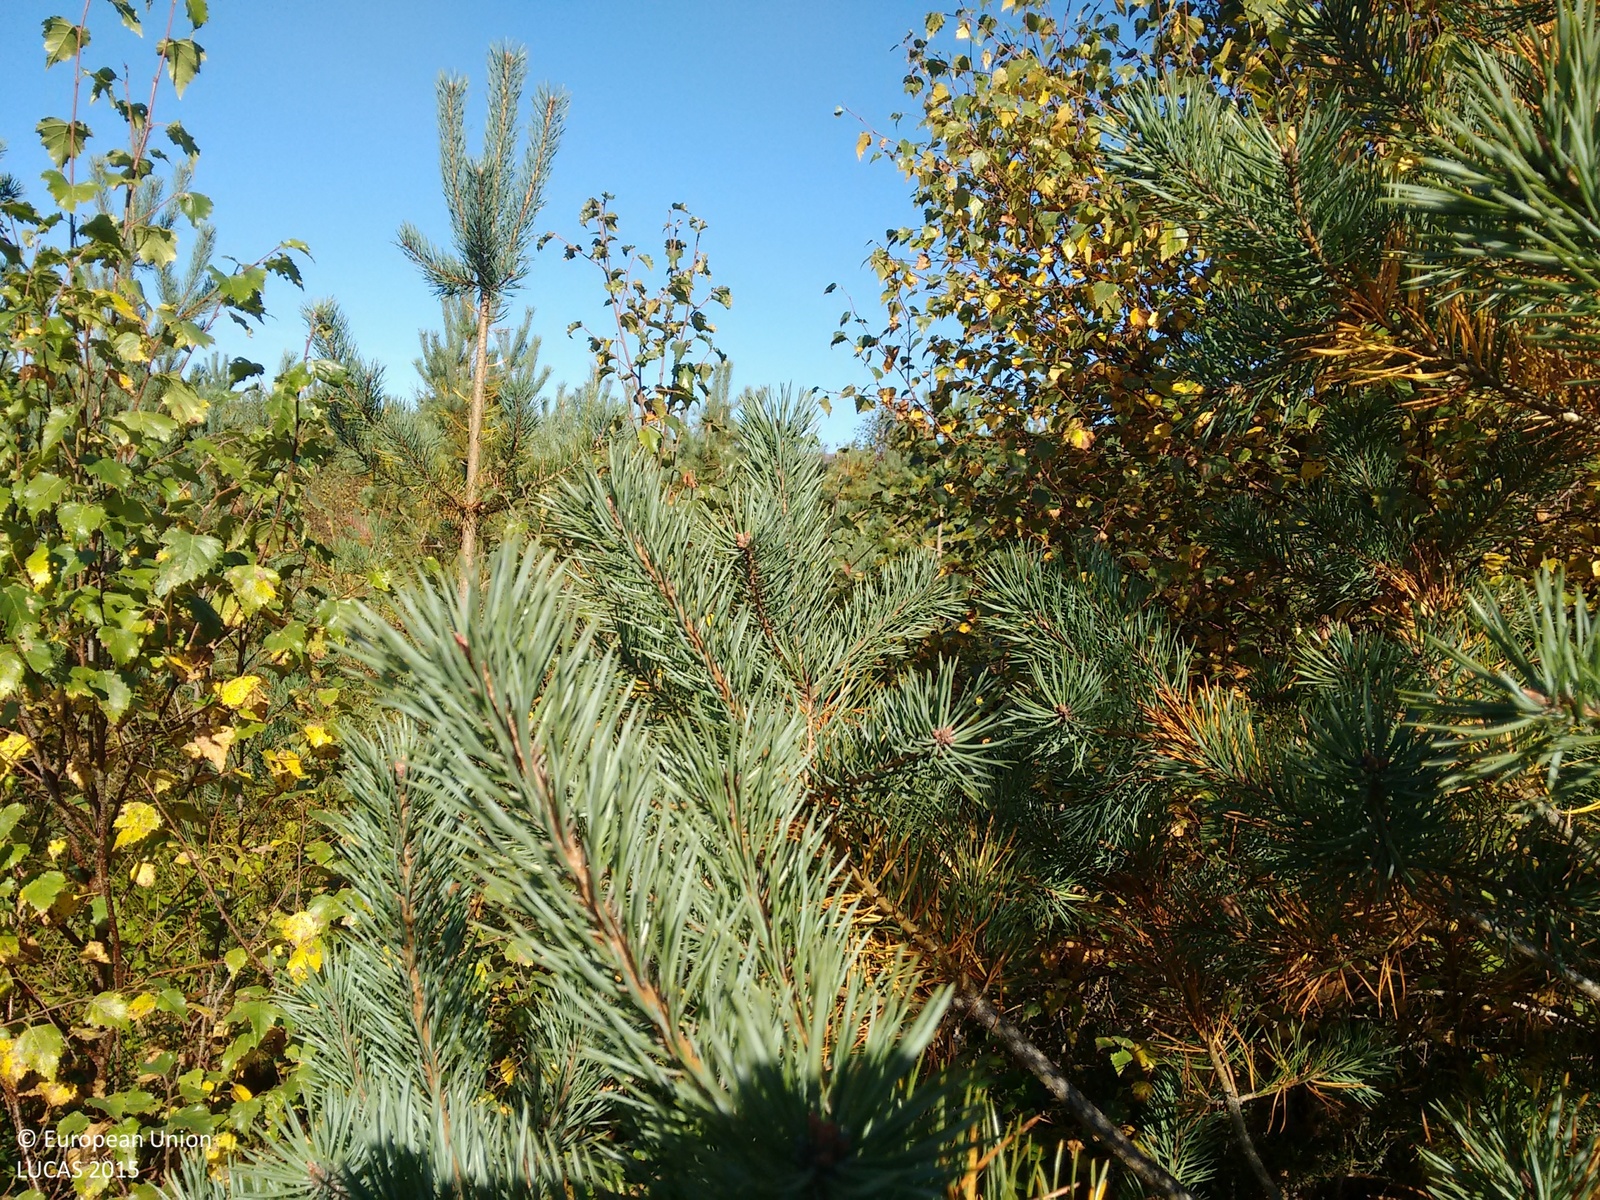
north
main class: Woodland
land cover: Pine dominated mixed woodland
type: exotic forest
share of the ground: > 75 %
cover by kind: coniferous forest trees 60 %, broadleaved forest trees 30 %, shrubs 10 %
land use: Forestry
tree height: < 5 m
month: September
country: GB
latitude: 56.0921
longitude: -4.4827
